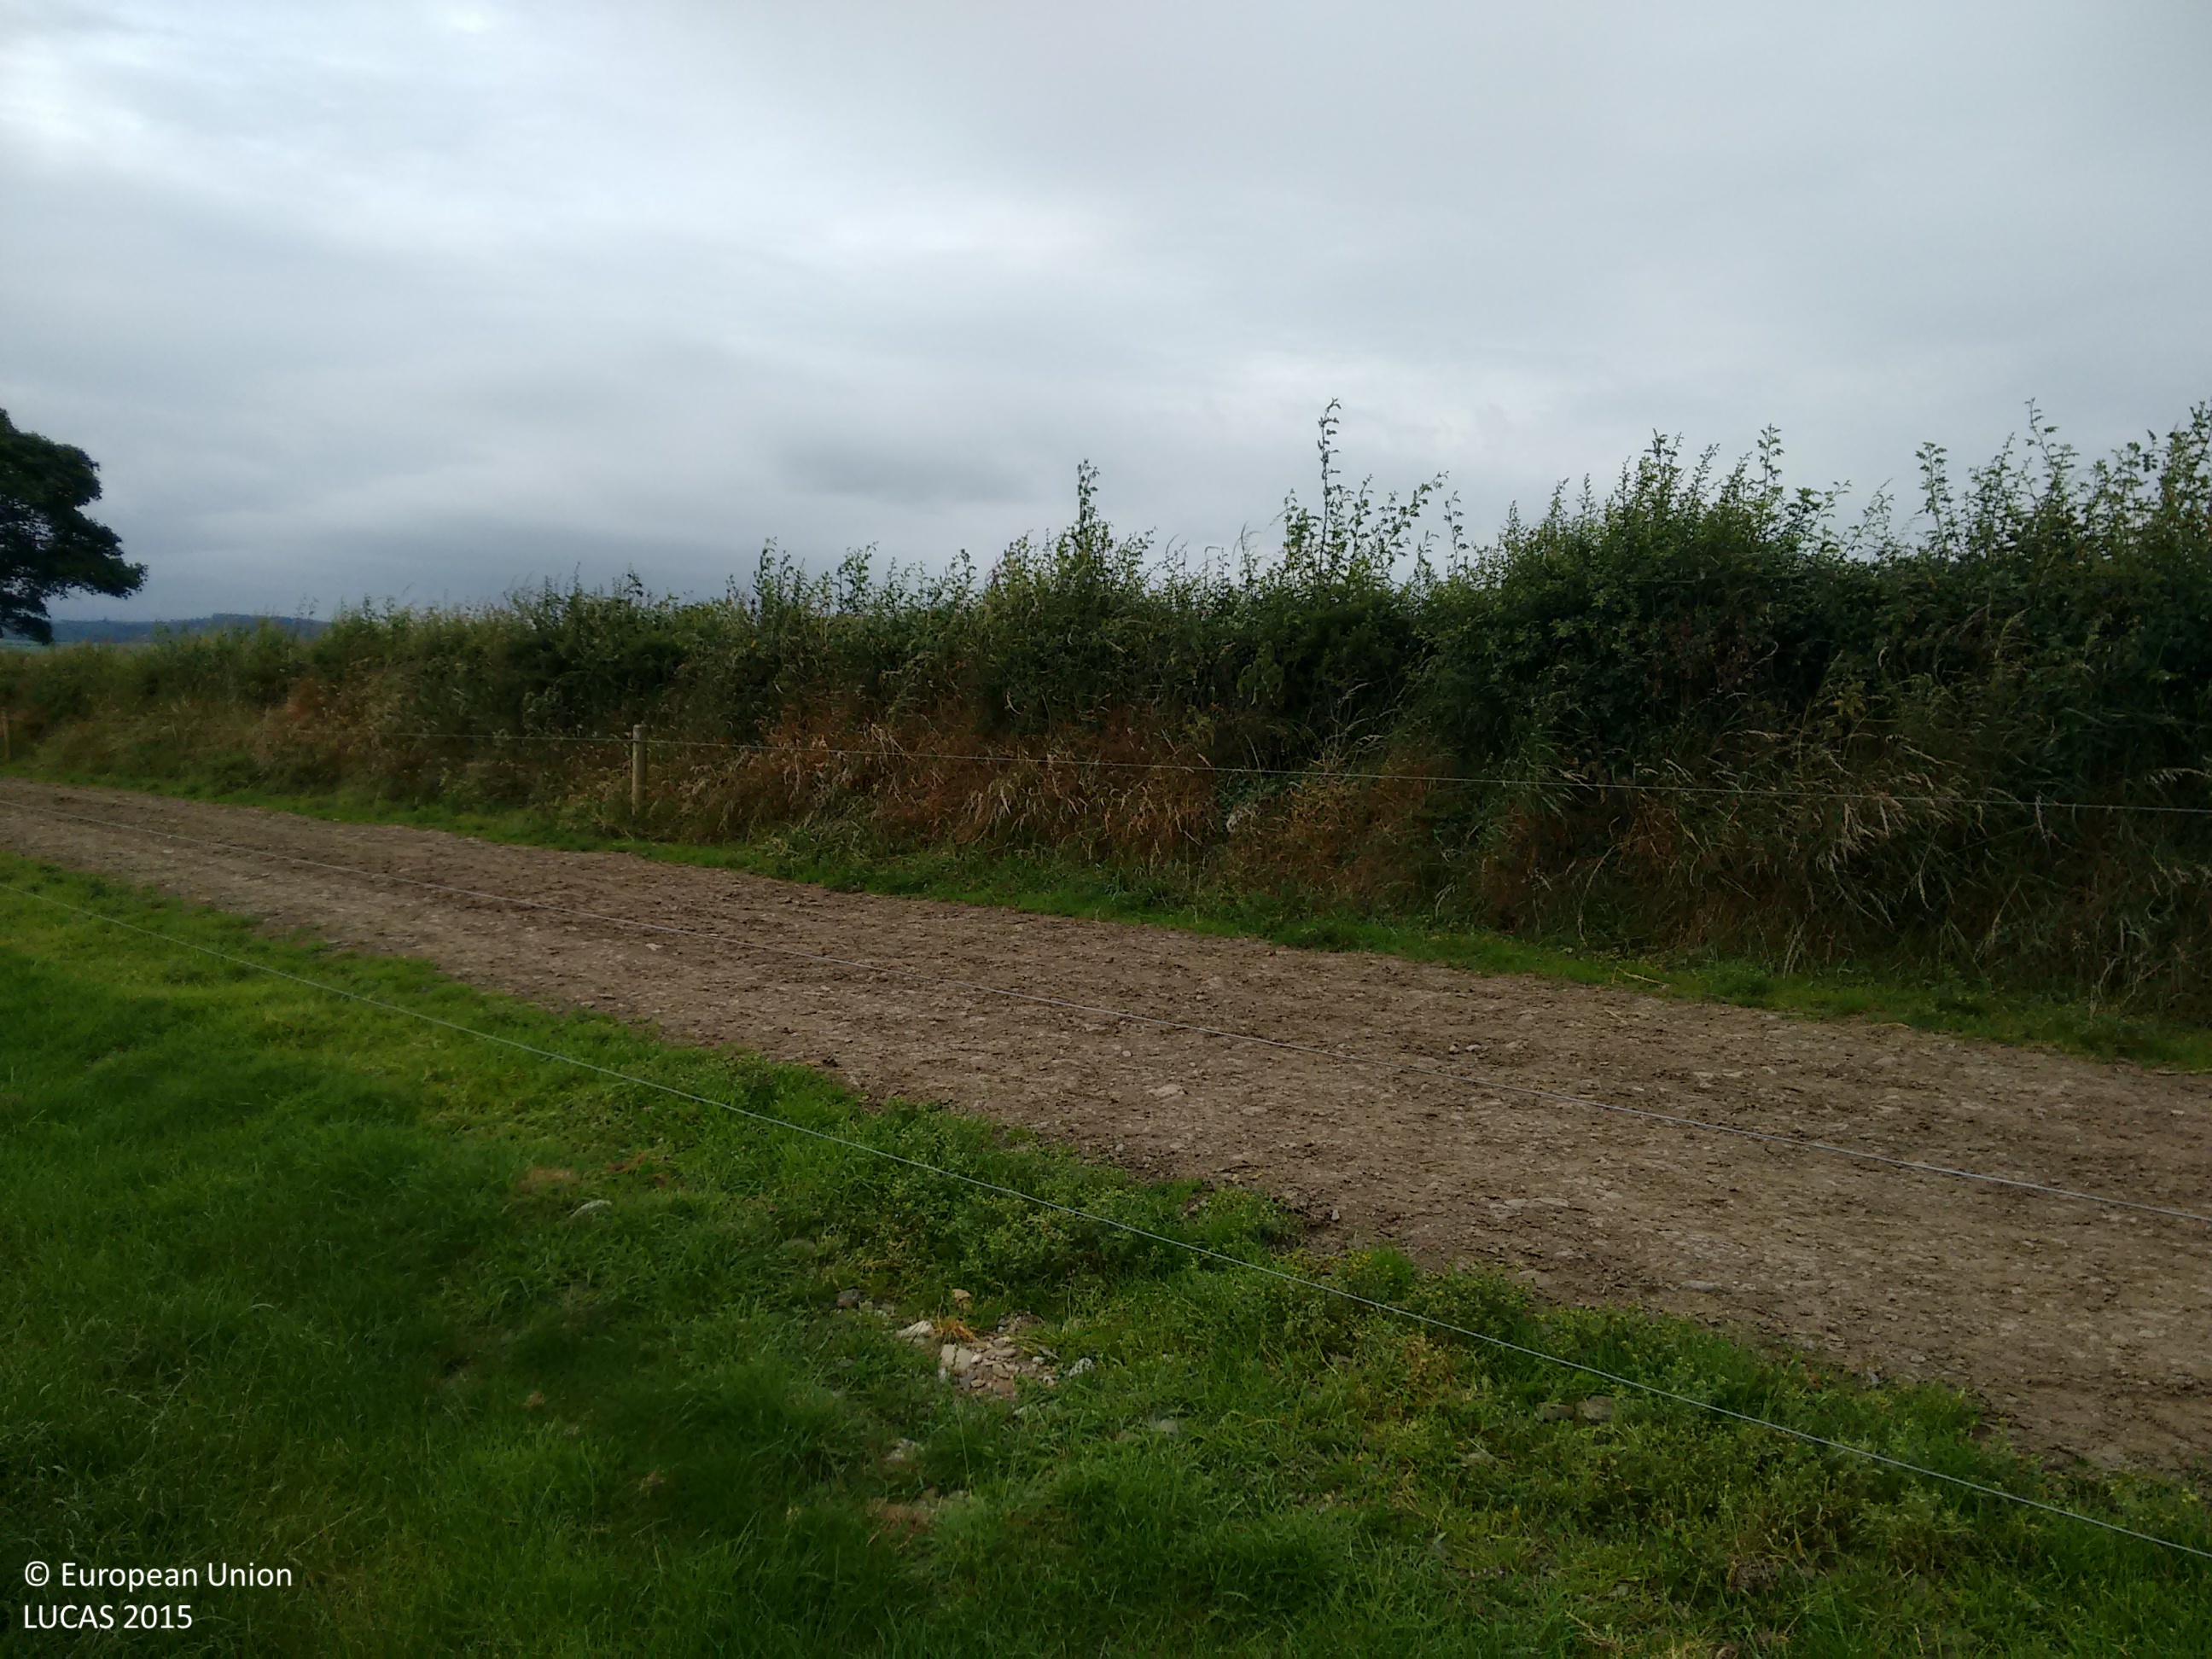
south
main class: Grassland
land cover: Grassland without tree/shrub cover
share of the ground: > 75 %
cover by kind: herbaceous plants 100 %
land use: Agriculture (excluding fallow land and kitchen gardens)
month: July
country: IE
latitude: 52.7127
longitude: -7.5535
